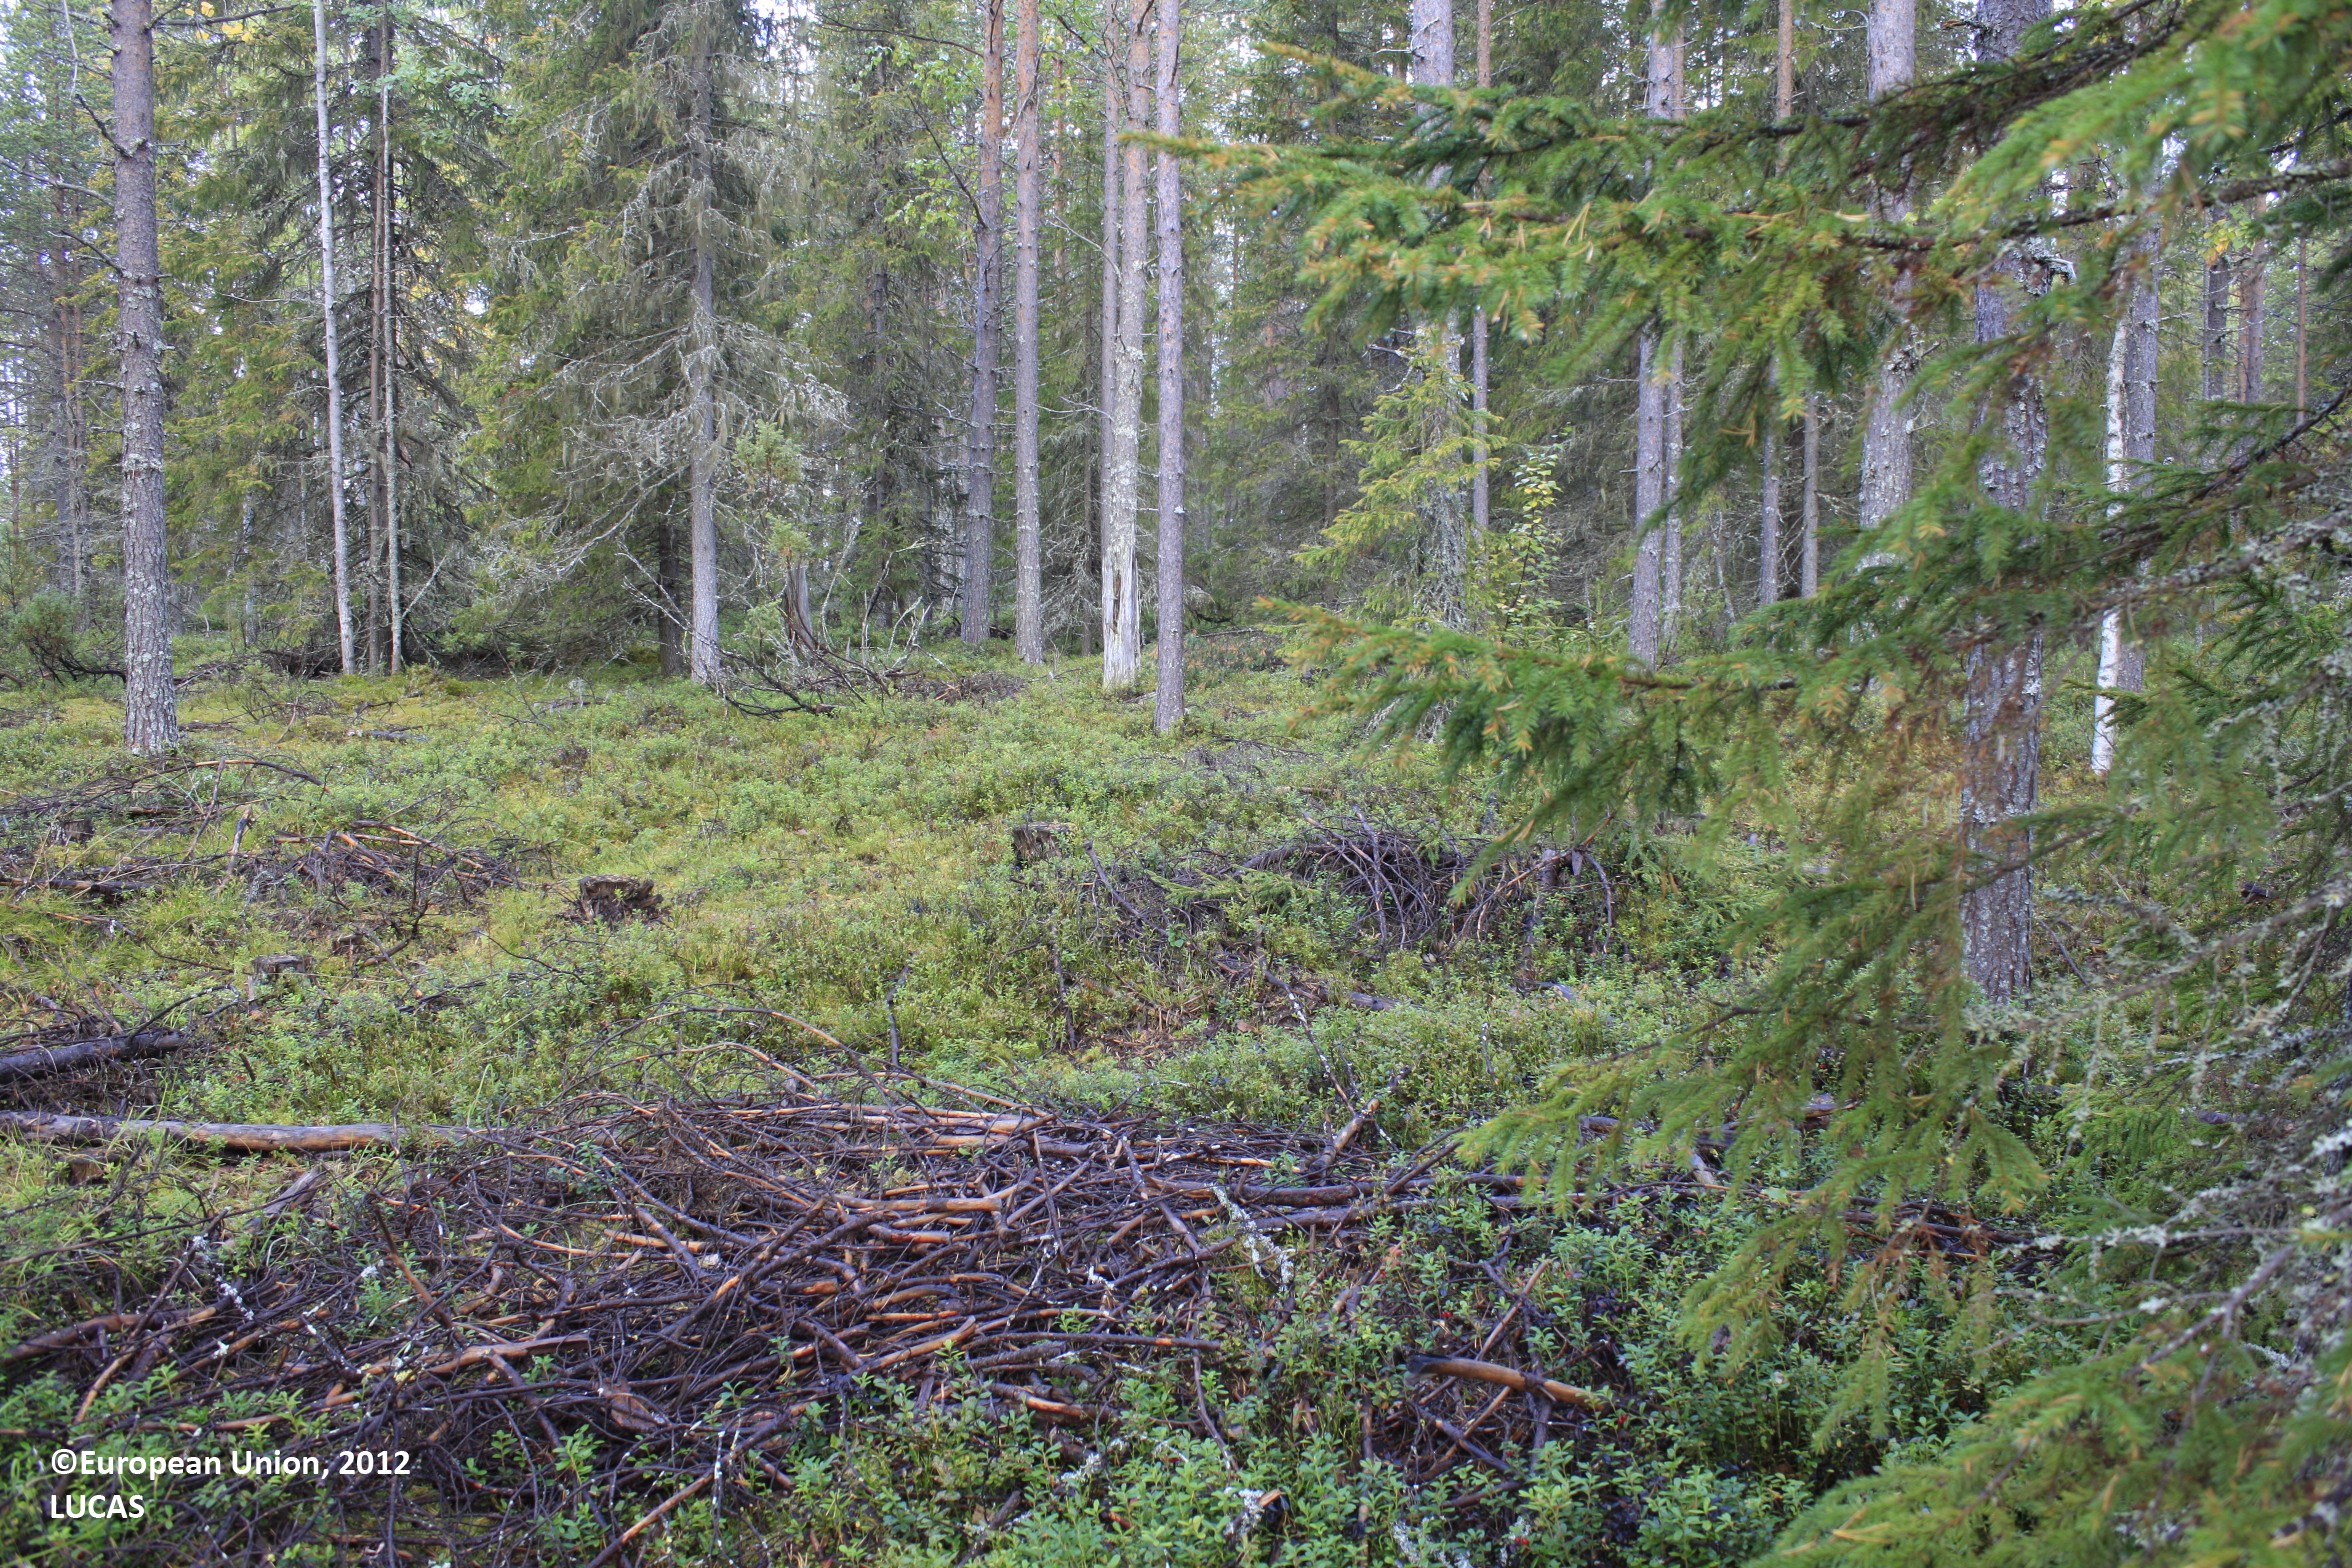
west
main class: Woodland
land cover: Pine dominated mixed woodland
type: boreal forest
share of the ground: 25 - 50 %
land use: Forestry
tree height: > 5 m
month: September
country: FI
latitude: 65.6367
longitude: 26.7249
